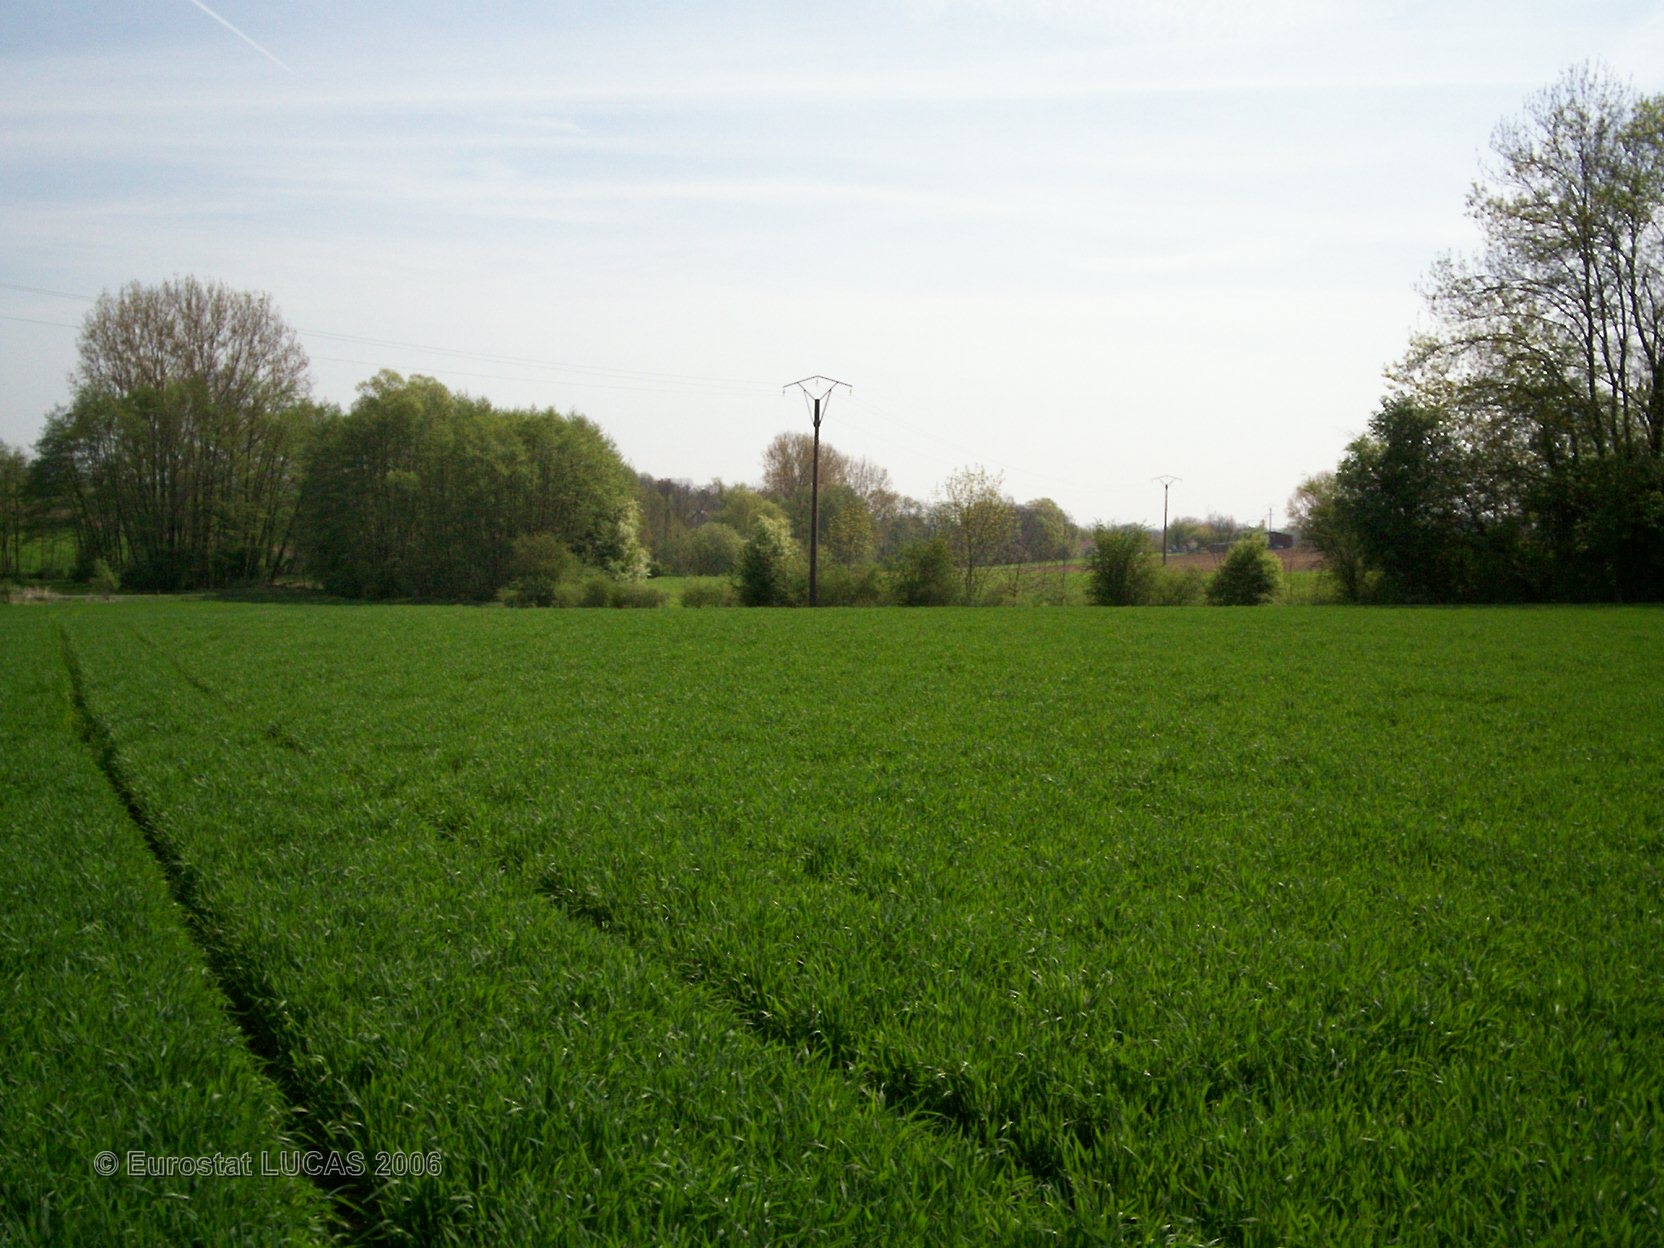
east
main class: Cropland
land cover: Common wheat
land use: Agriculture (excluding fallow land and kitchen gardens)
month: May
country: FR
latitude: 47.6535
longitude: 7.4319
